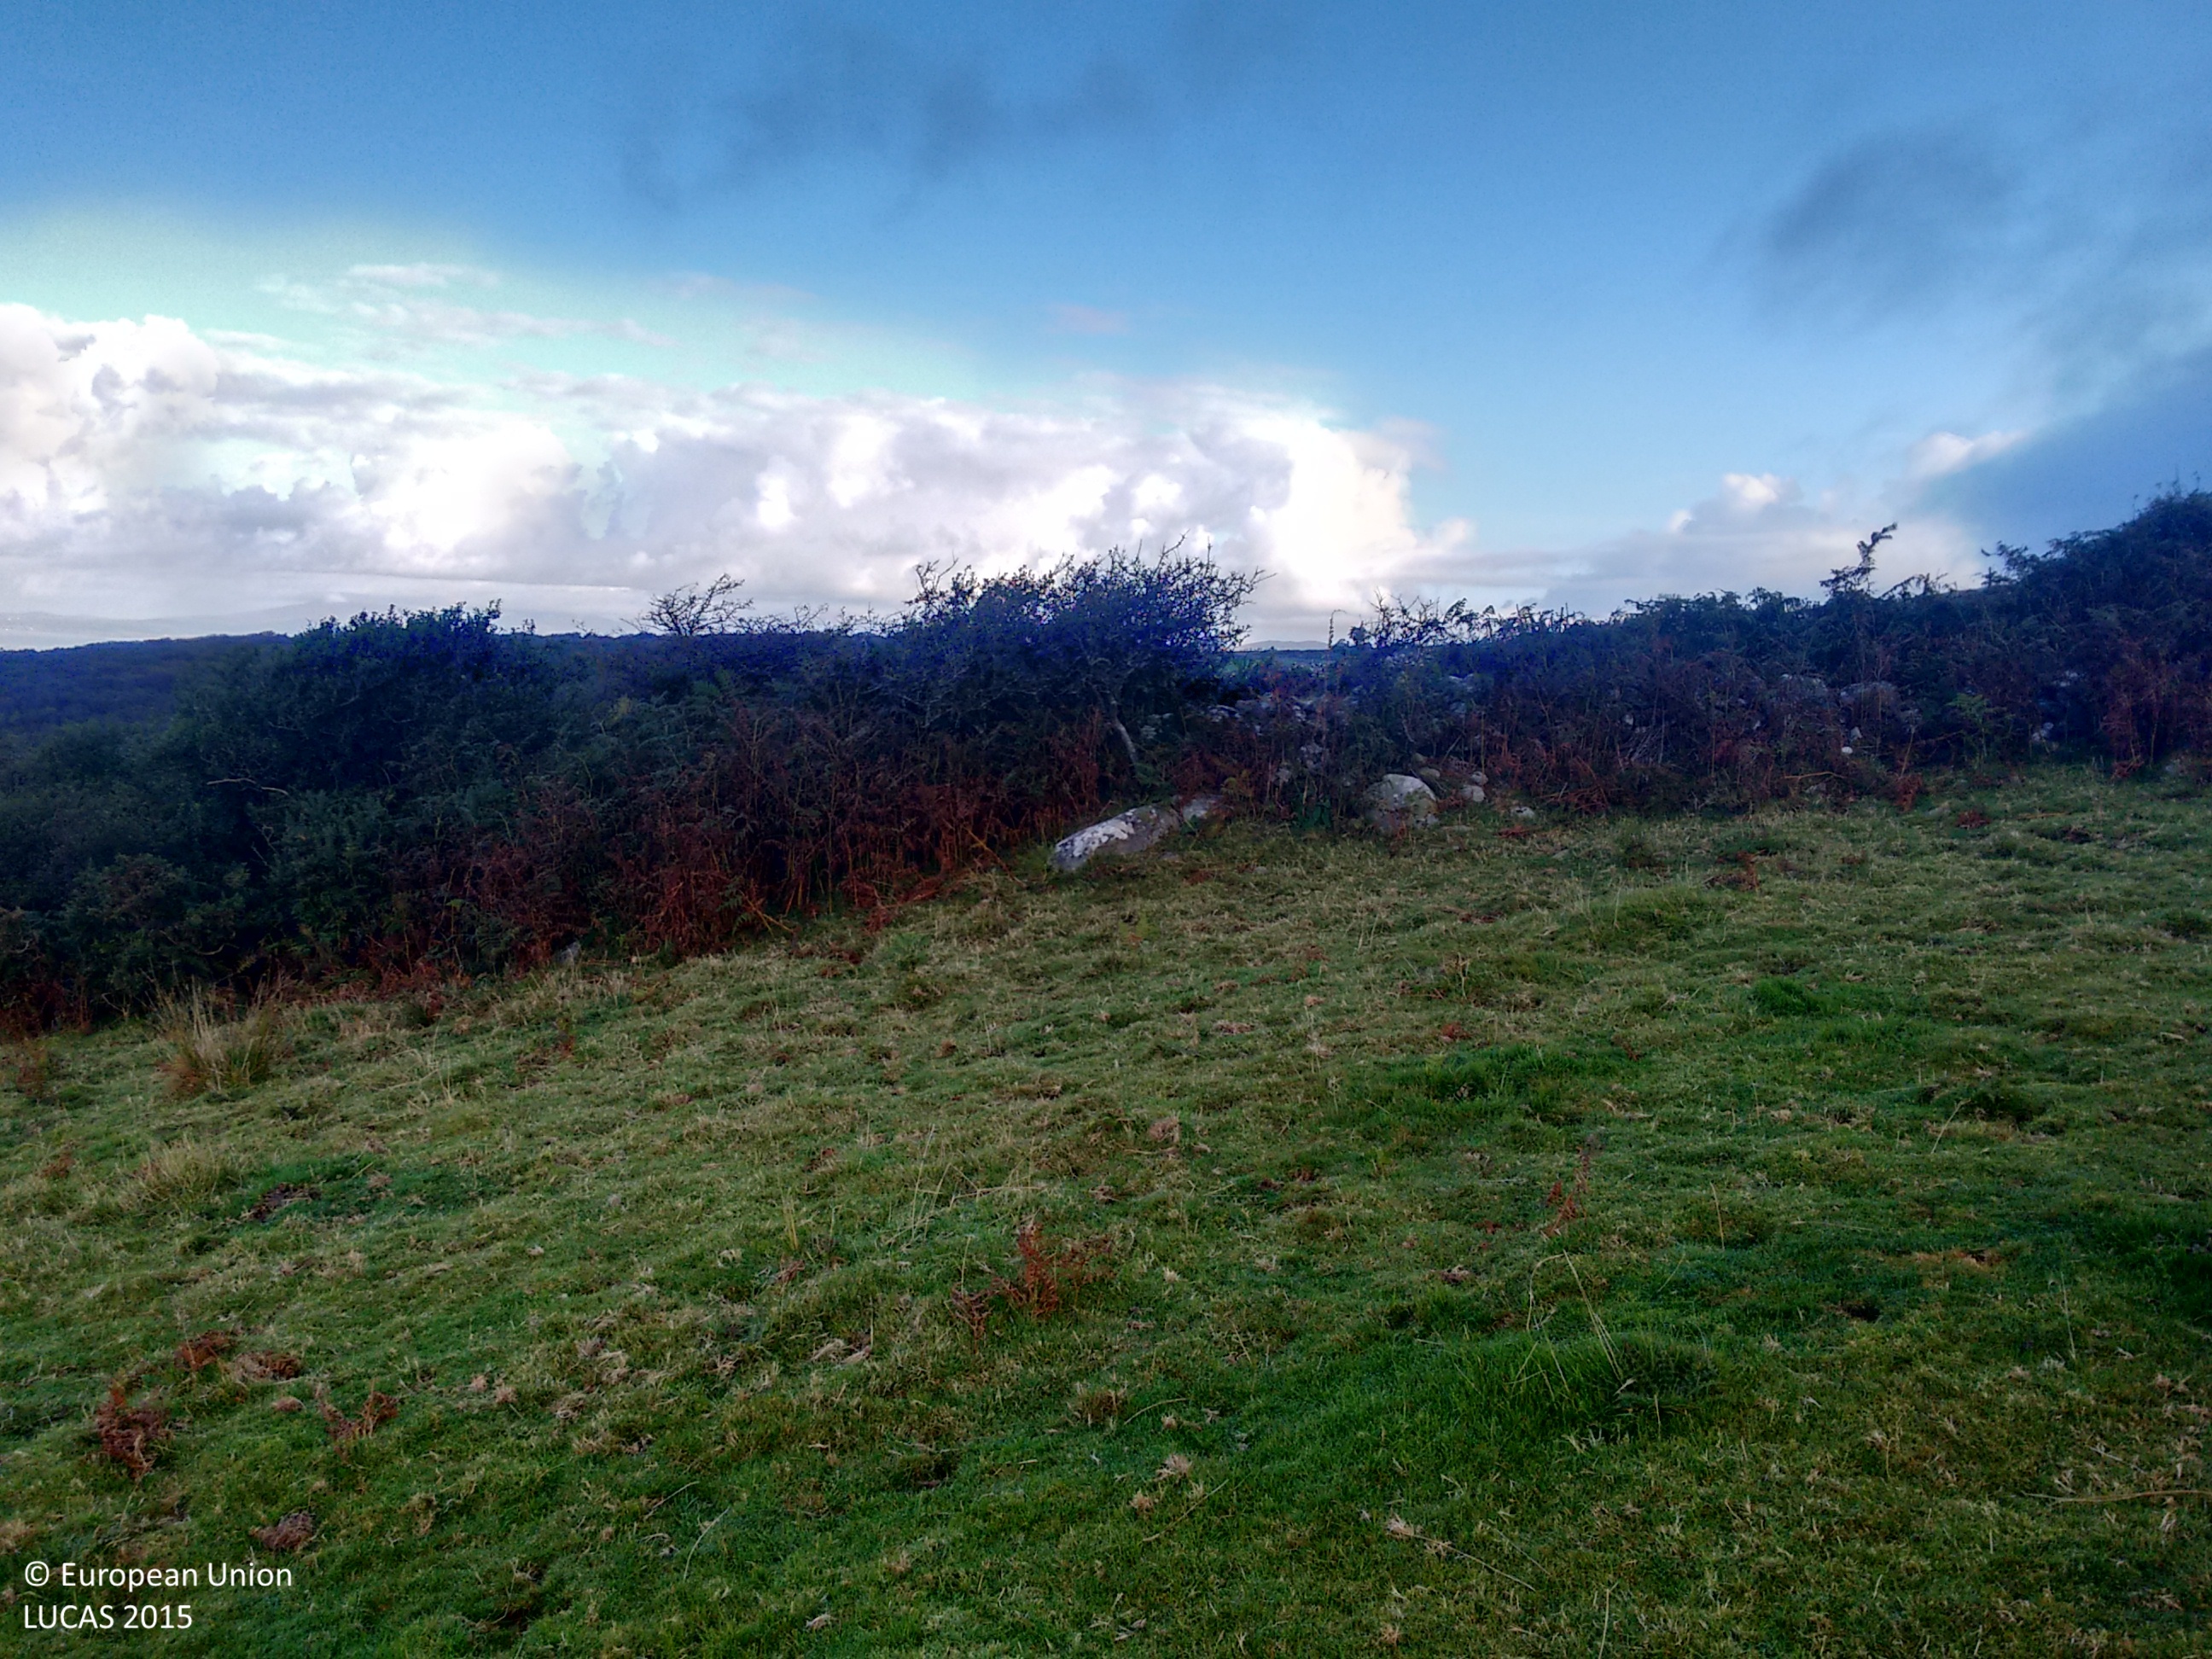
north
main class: Grassland
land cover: Grassland without tree/shrub cover
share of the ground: > 75 %
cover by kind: herbaceous plants 100 %
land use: Agriculture (excluding fallow land and kitchen gardens)
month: October
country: GB
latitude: 52.7752
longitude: -4.0747
